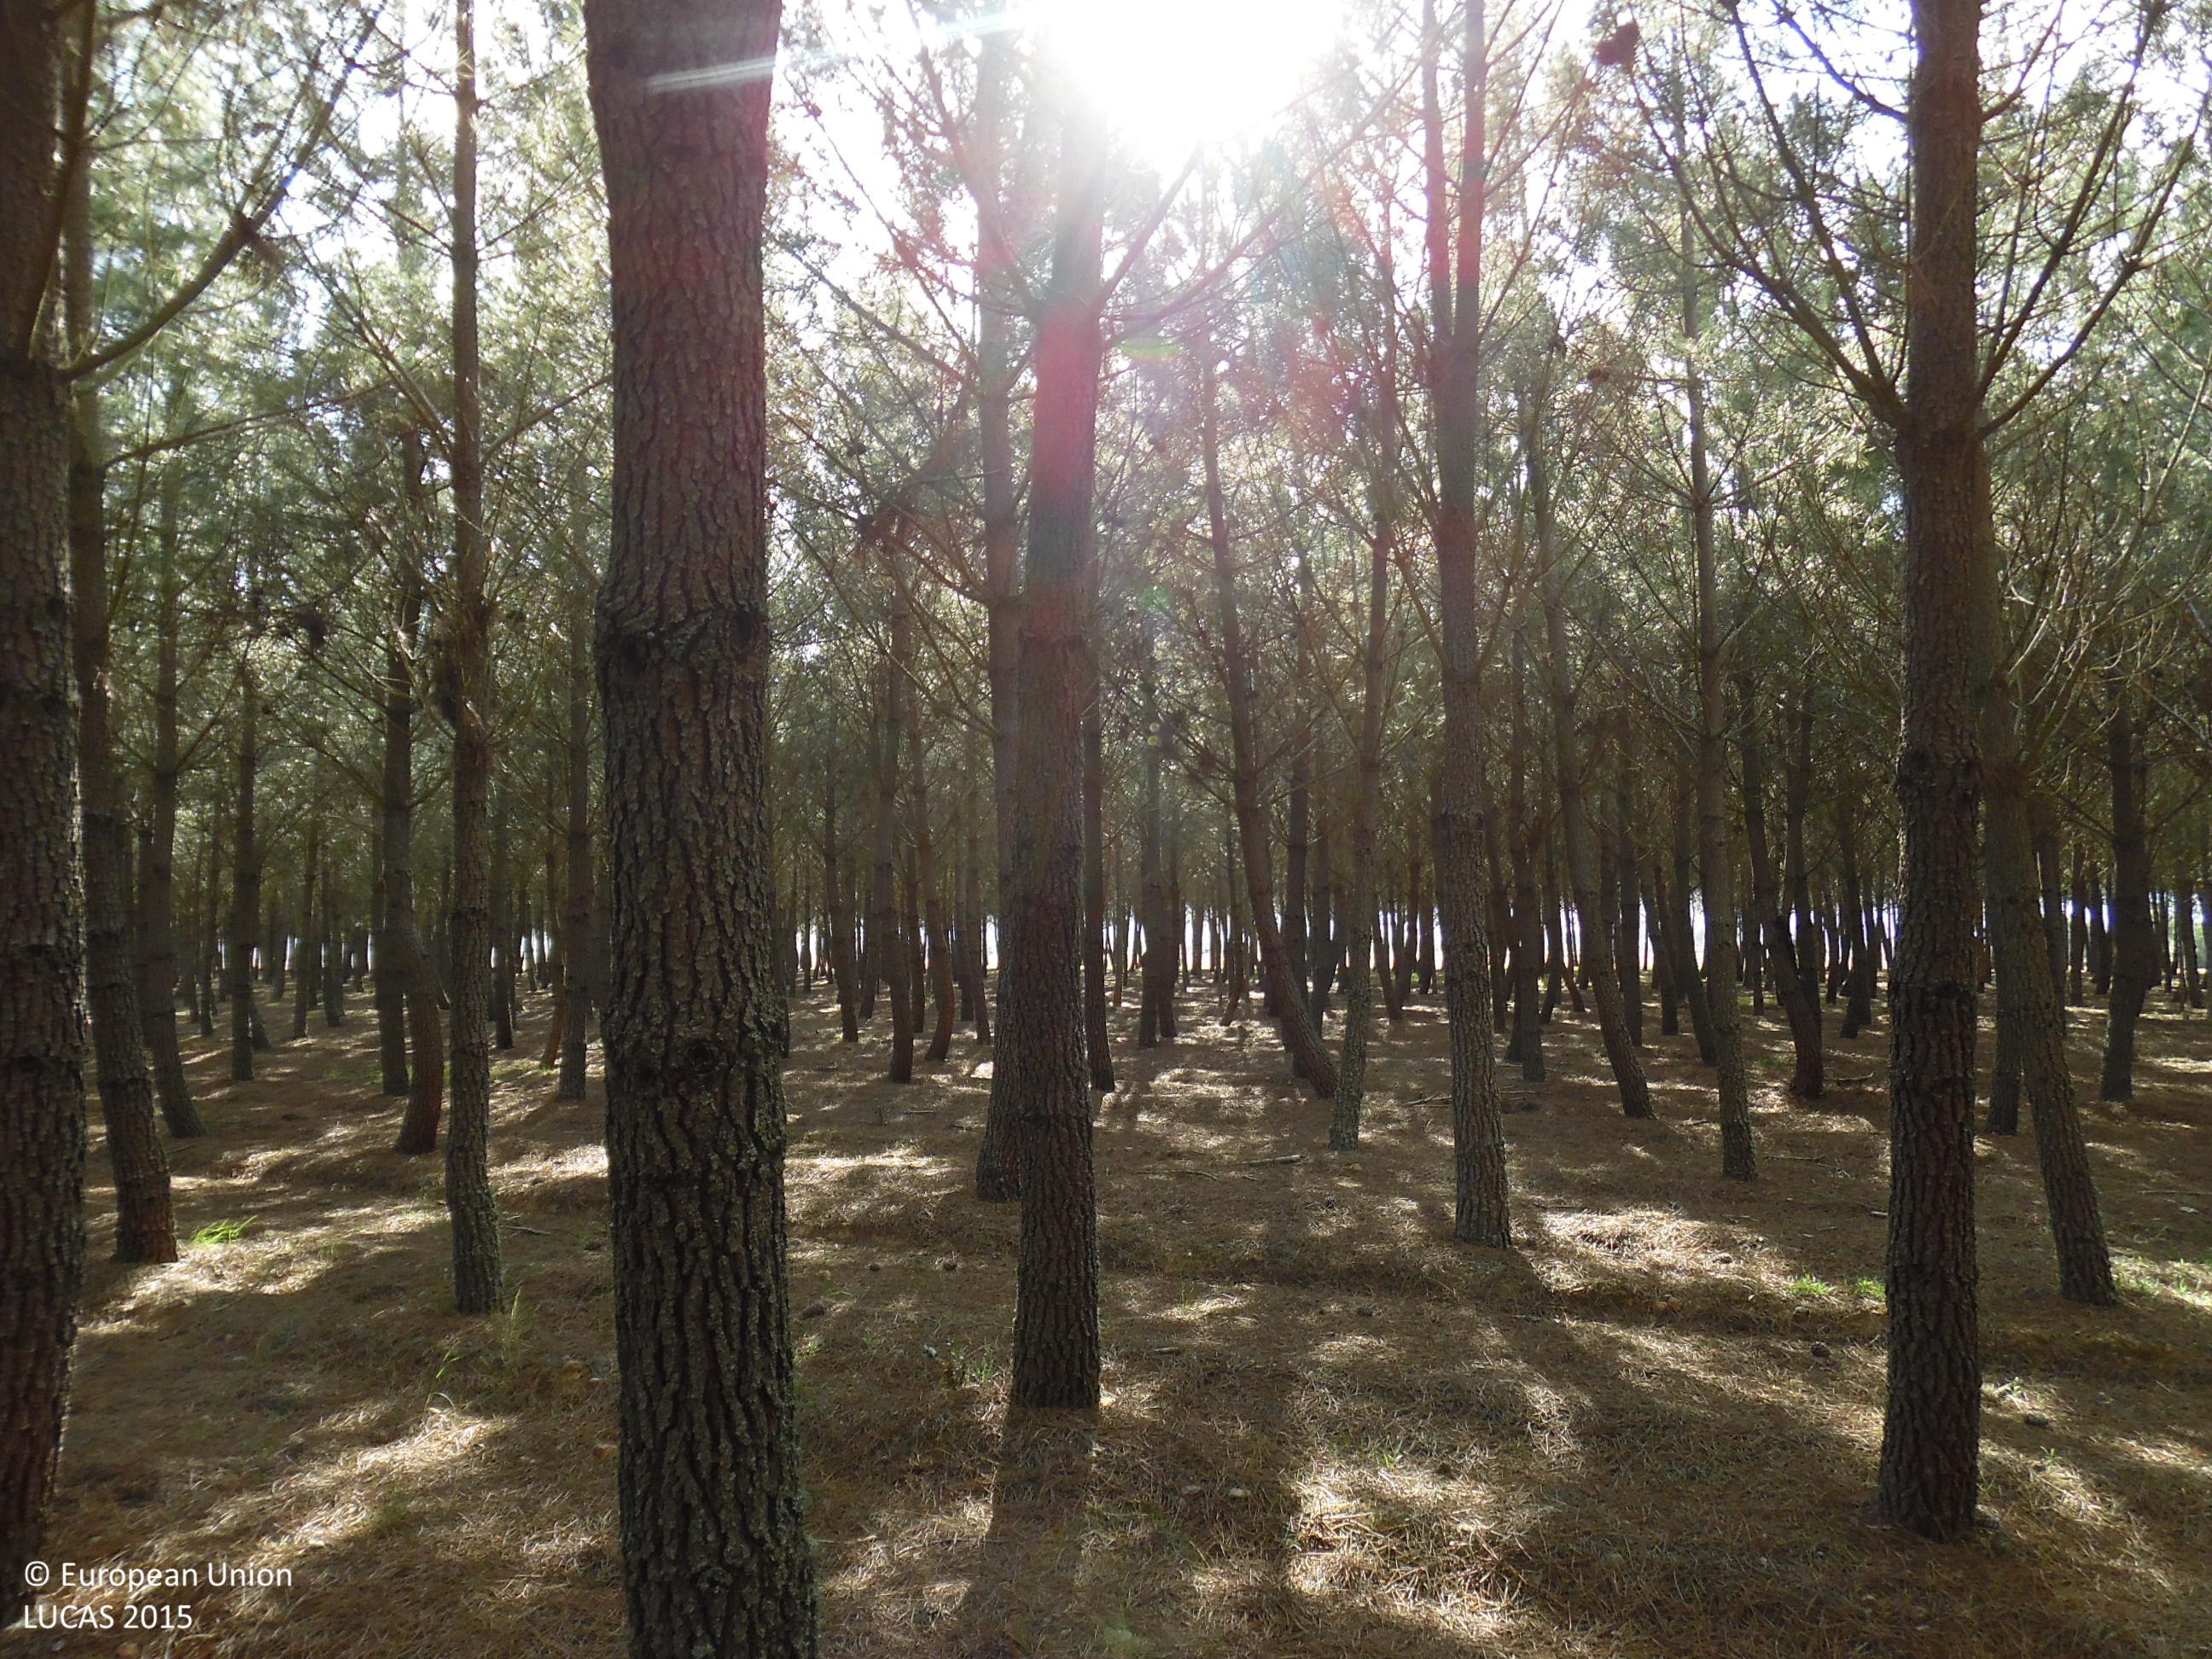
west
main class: Woodland
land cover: Pine dominated coniferous woodland
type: coniferous forest of the mediterranean region
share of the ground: > 75 %
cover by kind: coniferous forest trees 100 %
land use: Forestry
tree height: > 5 m
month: April
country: ES
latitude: 42.2403
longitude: -6.0880
